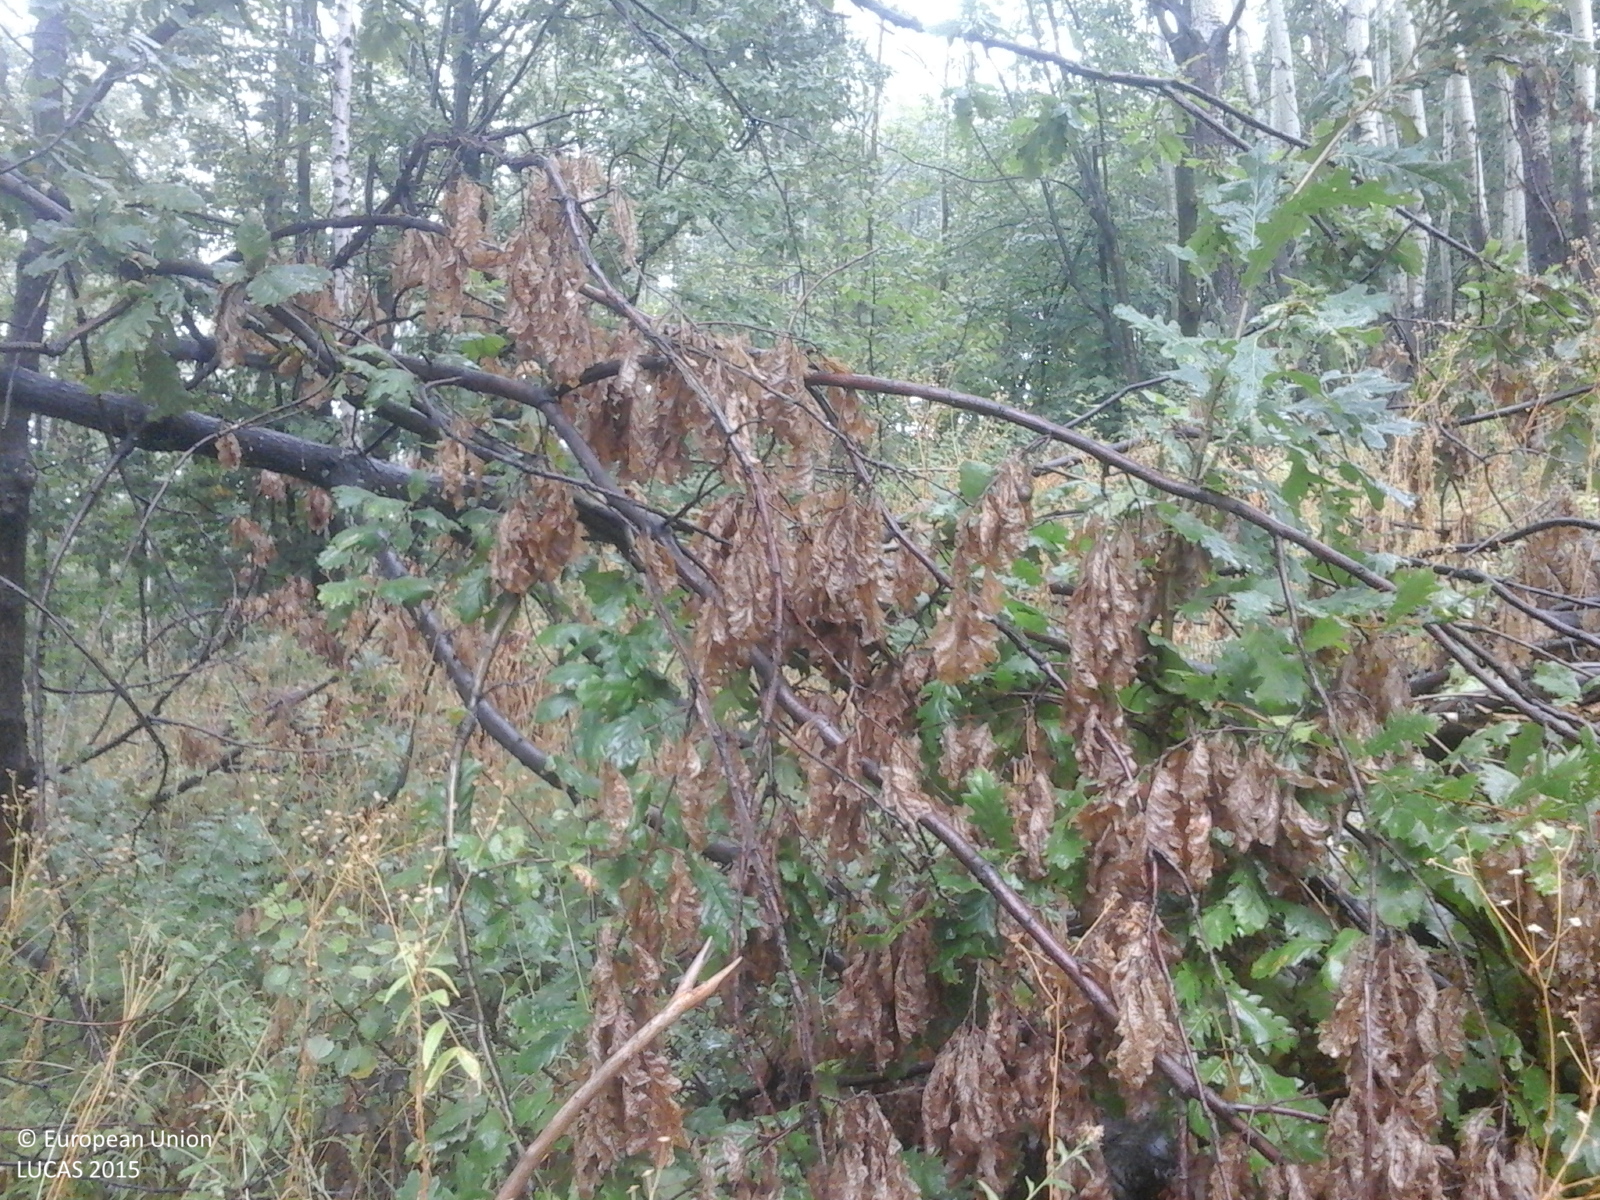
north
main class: Woodland
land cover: Broadleaved woodland
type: acidophilous oak and oak-birch forest
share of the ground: > 75 %
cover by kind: broadleaved forest trees 100 %
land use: Forestry
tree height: > 5 m
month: August
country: RO
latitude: 44.9614
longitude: 22.1694
